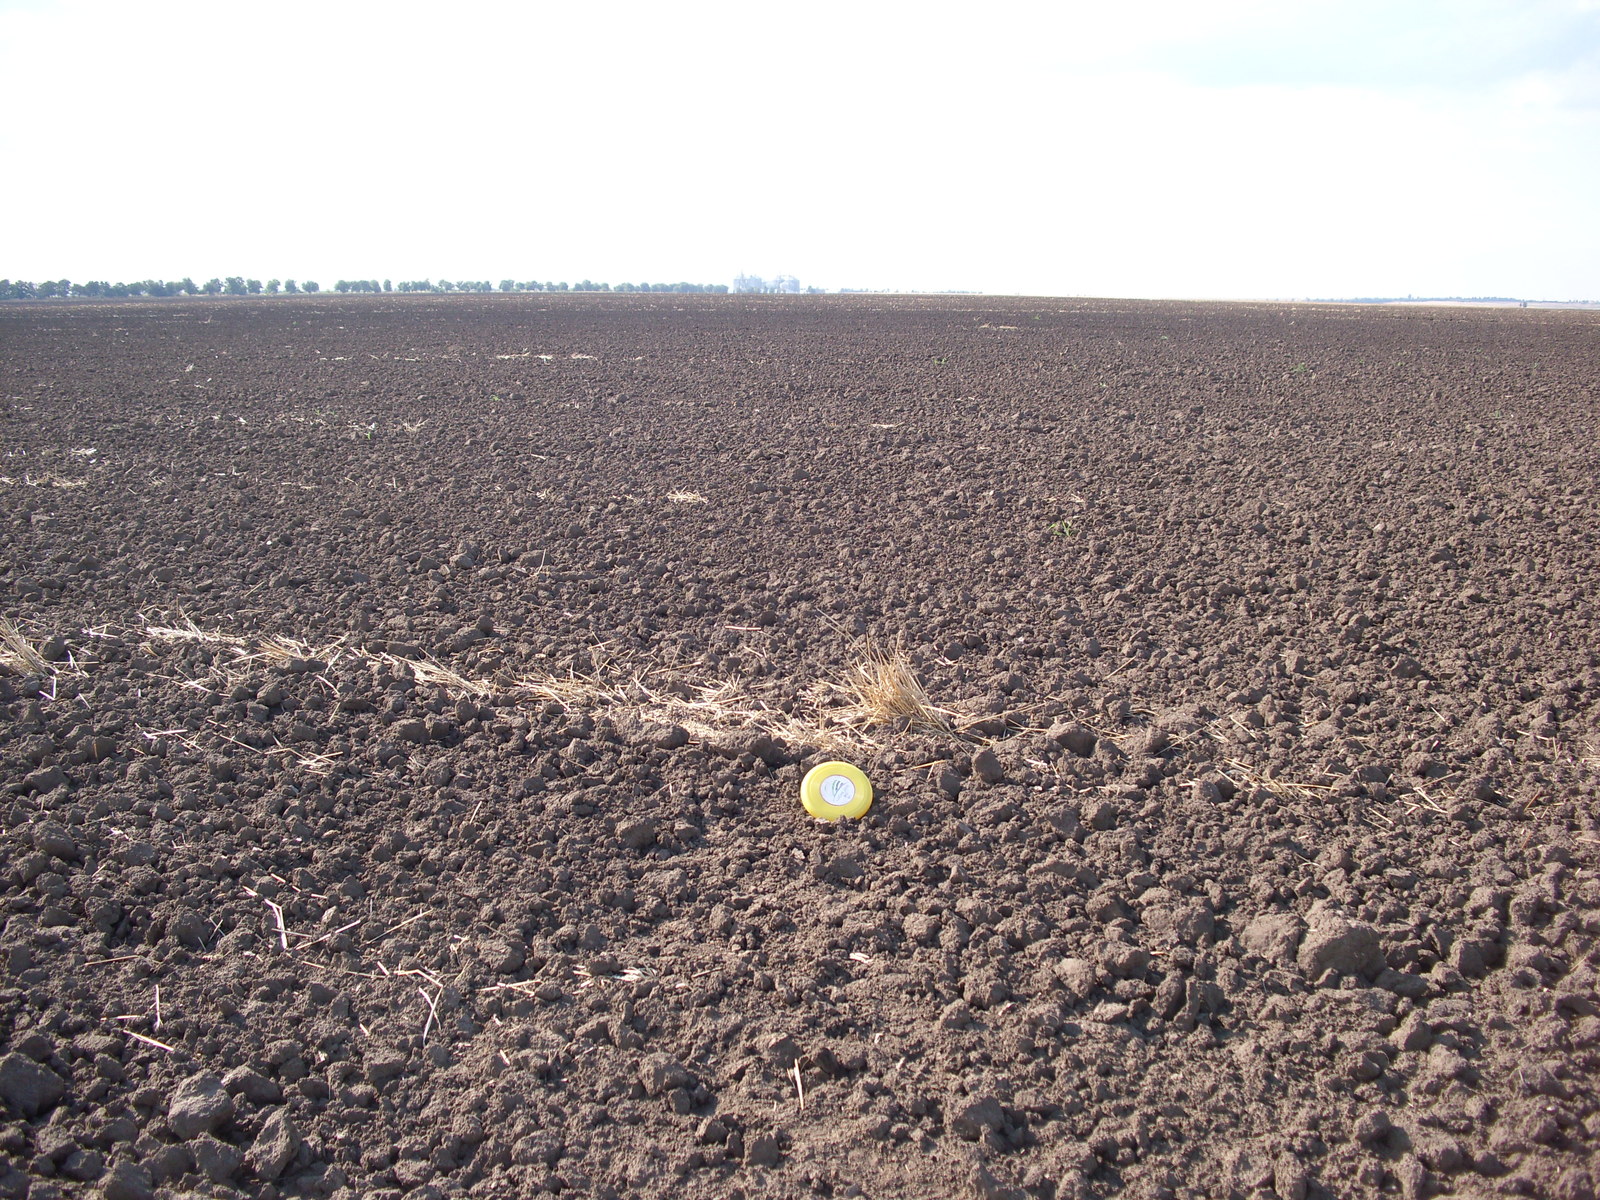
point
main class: Cropland
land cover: Common wheat
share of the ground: < 10 %
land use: Agriculture (excluding fallow land and kitchen gardens)
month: August
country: BG
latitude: 43.7466
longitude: 23.2938
